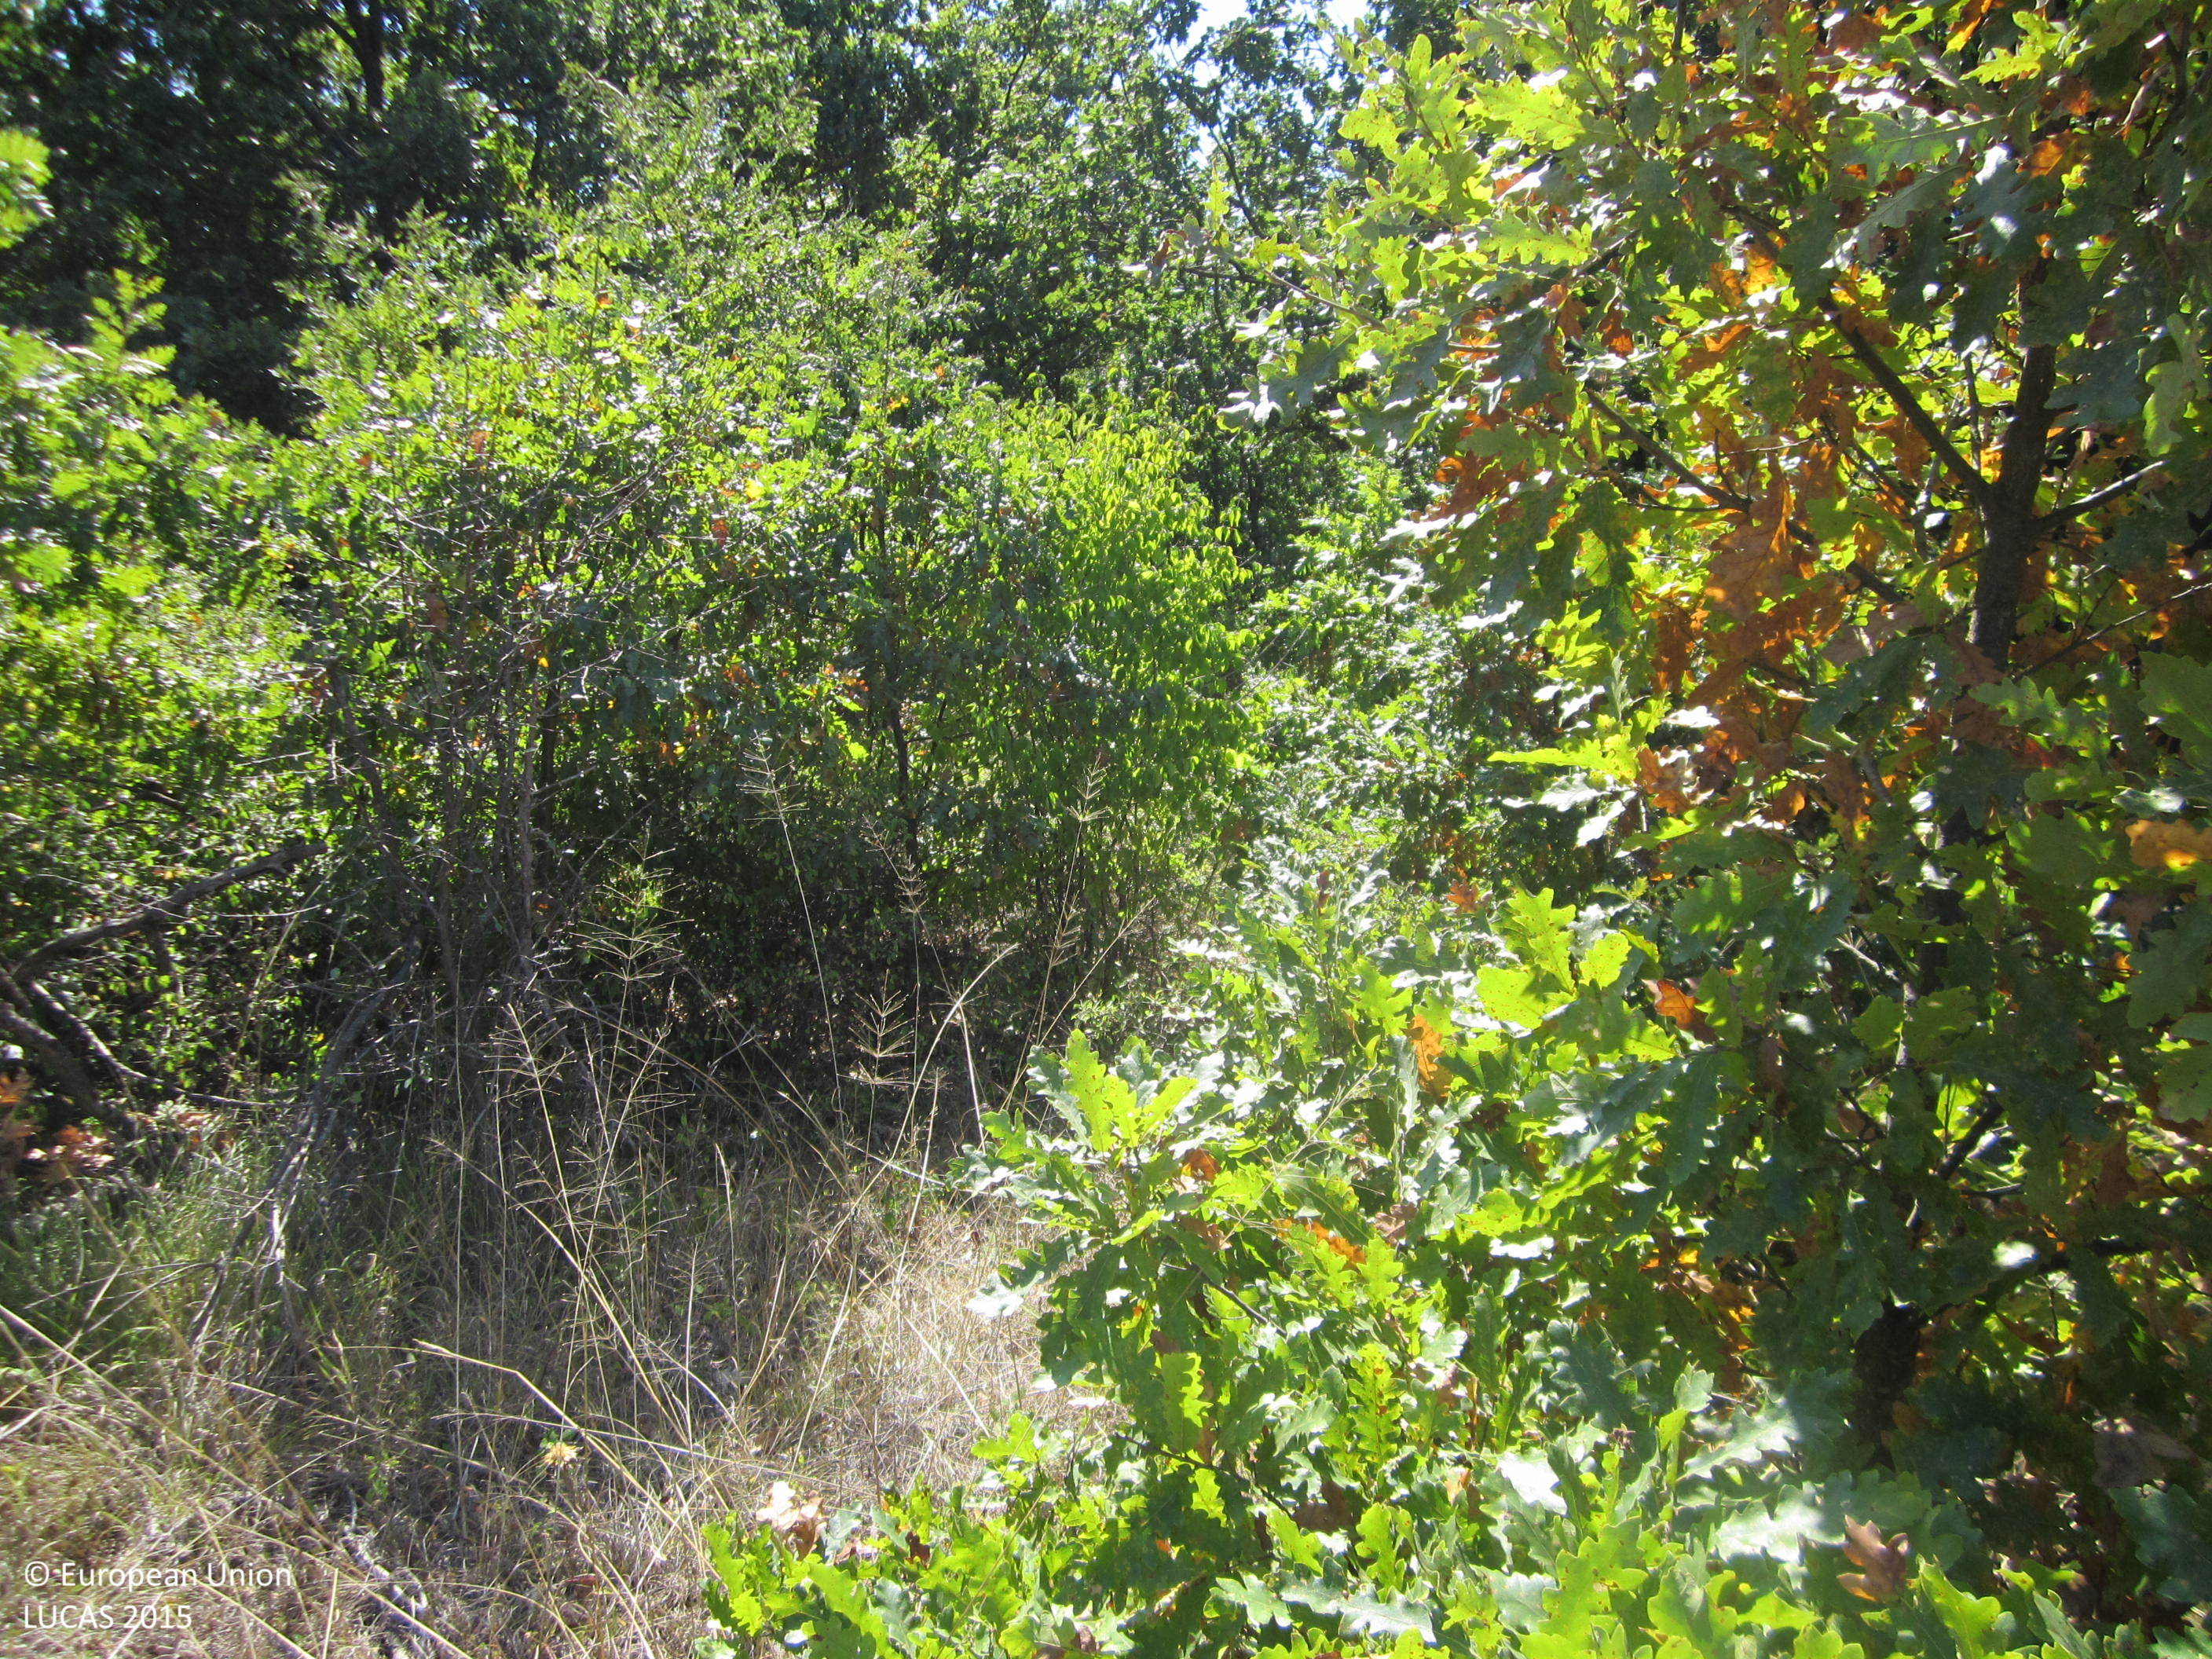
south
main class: Woodland
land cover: Broadleaved woodland
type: thermophilous deciduous forest
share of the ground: 25 - 50 %
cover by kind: broadleaved forest trees 45 %, herbaceous plants 45 %, shrubs 10 %
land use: Forestry
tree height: > 5 m
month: September
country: BG
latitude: 42.1525
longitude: 27.0558
